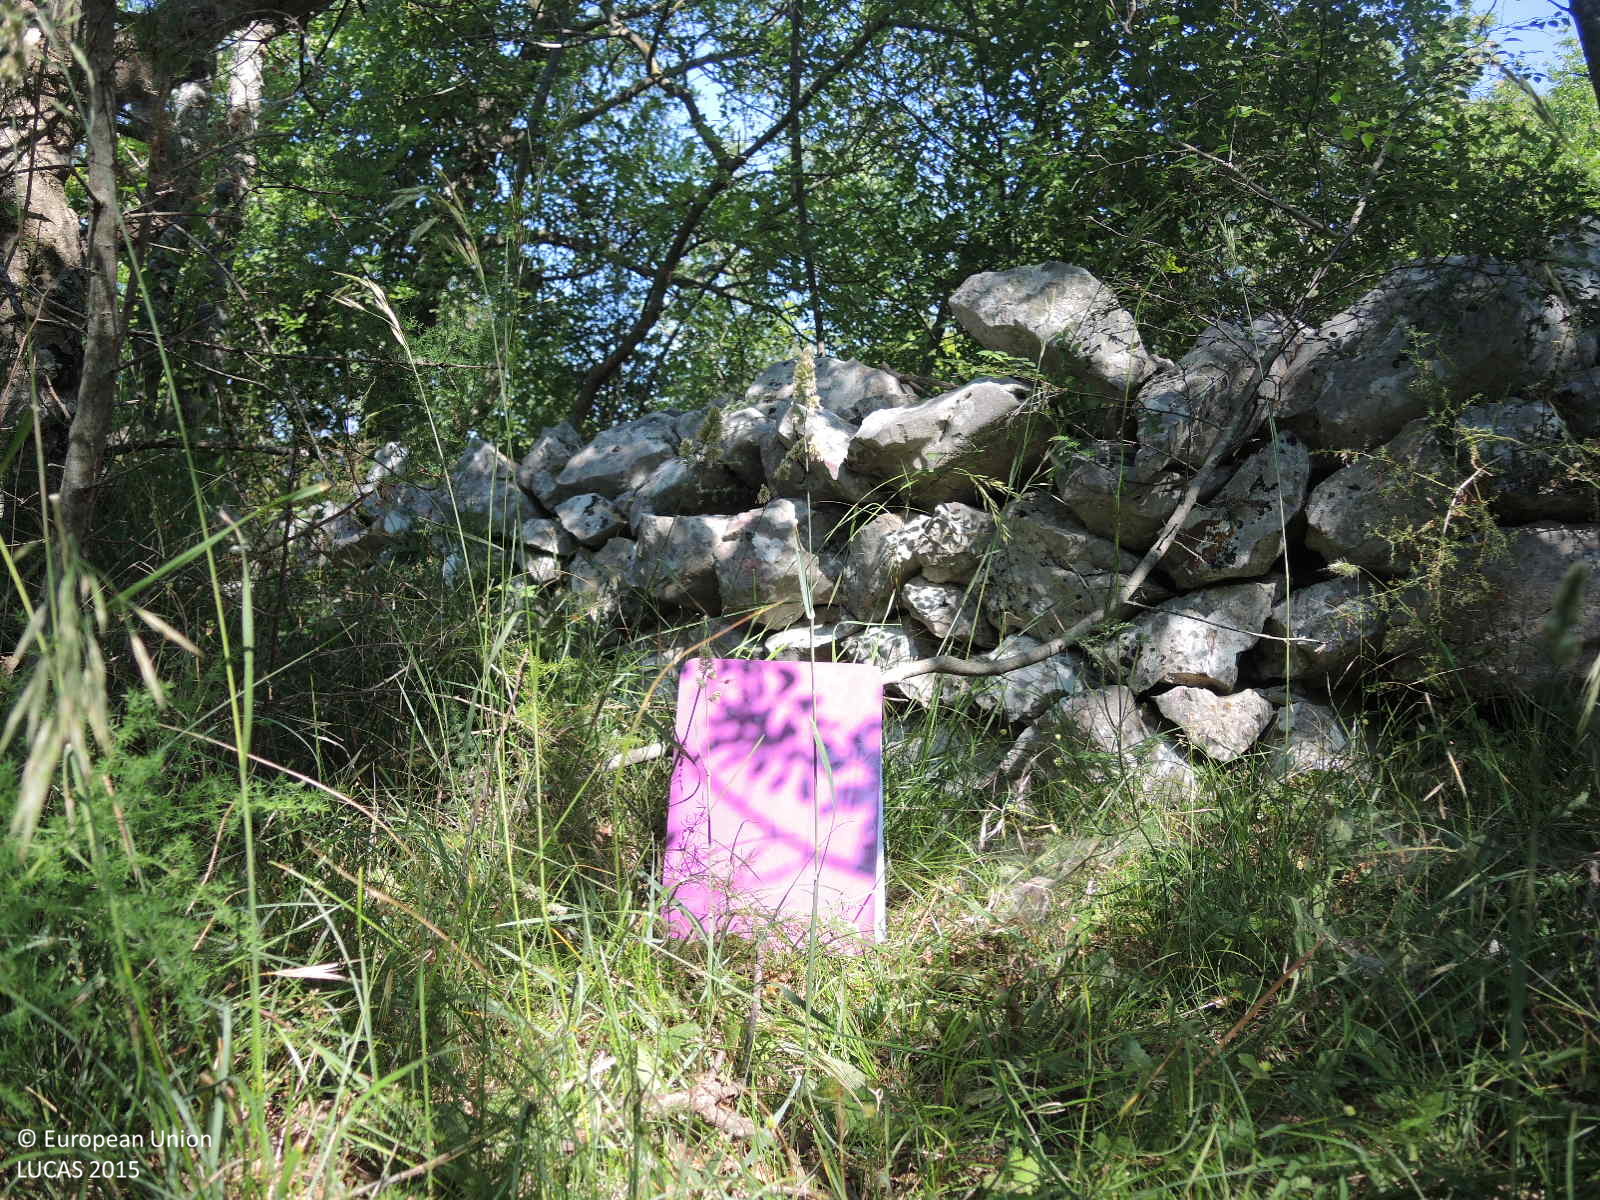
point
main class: Woodland
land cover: Broadleaved woodland
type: mesophytic deciduous forest
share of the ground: 50 - 75 %
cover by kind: broadleaved forest trees 60 %, shrubs 20 %, herbaceous plants 15 %, unconsolidated bare surface 5 %
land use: Semi-natural and natural areas not in use
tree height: > 5 m
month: June
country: HR
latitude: 43.6554
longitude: 16.2528
